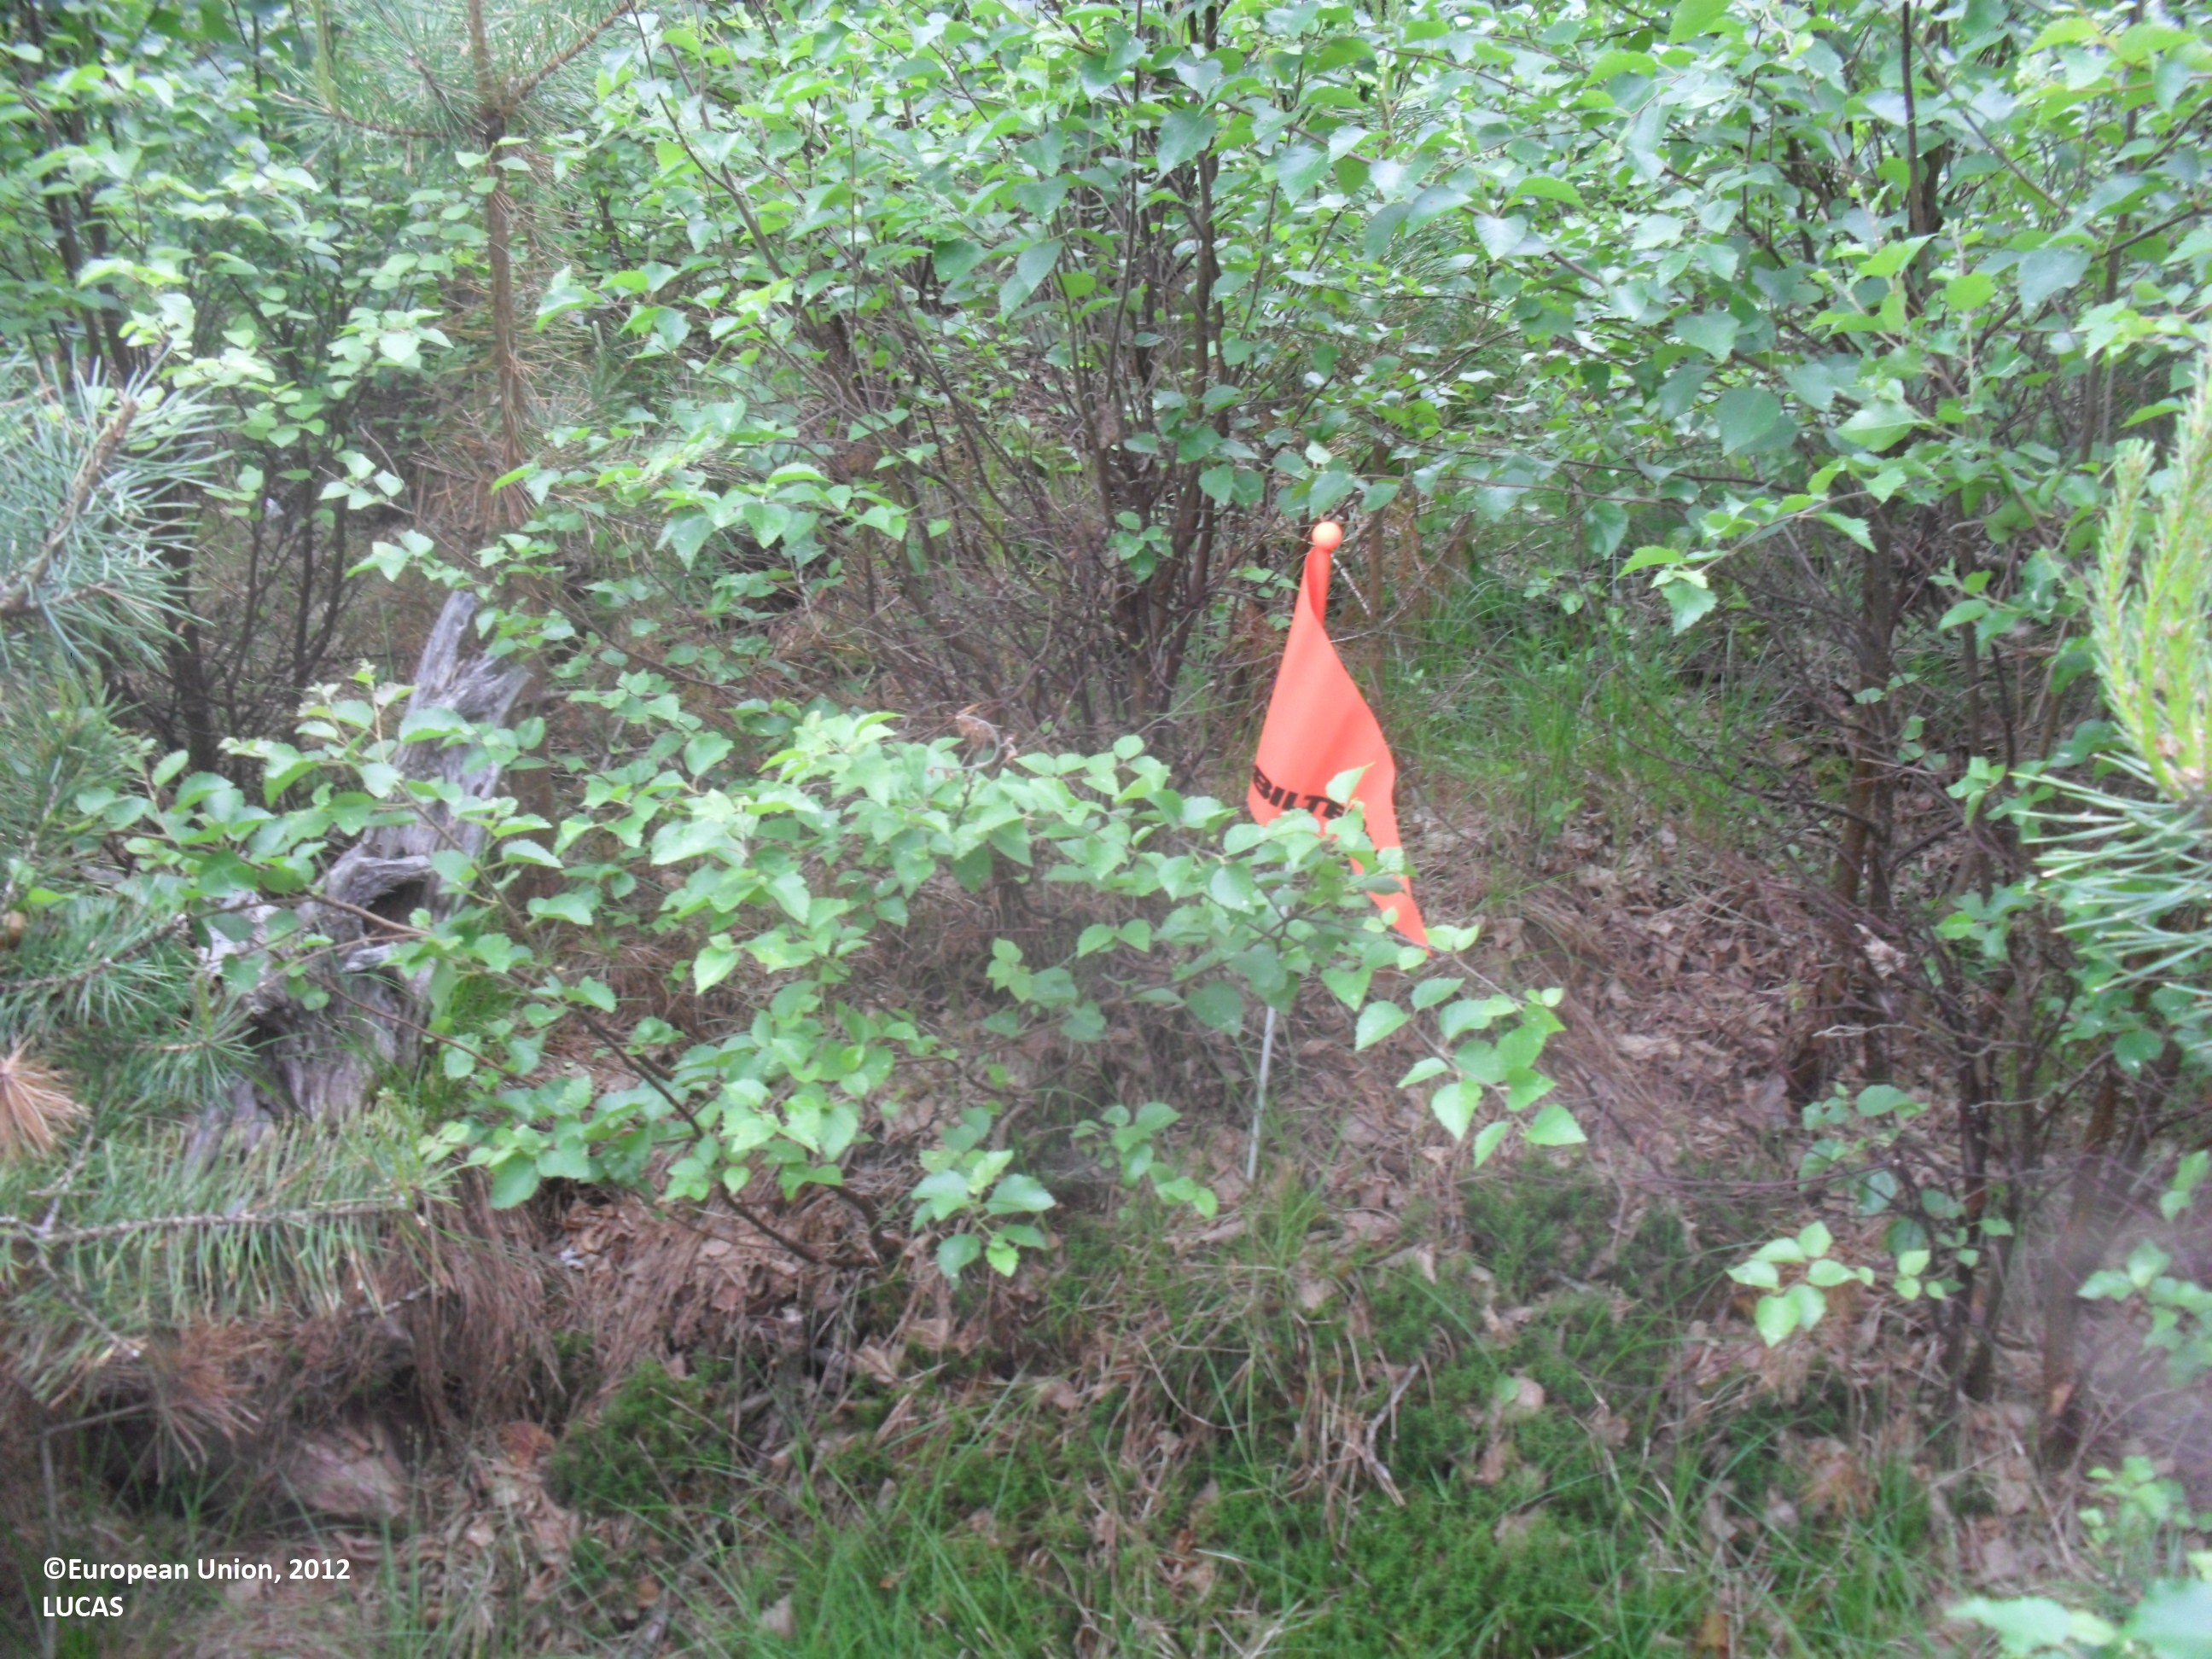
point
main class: Woodland
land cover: Other mixed woodland
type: boreal forest
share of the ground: 50 - 75 %
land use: Forestry
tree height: < 5 m
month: June
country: FI
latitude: 63.4854
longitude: 22.8822
